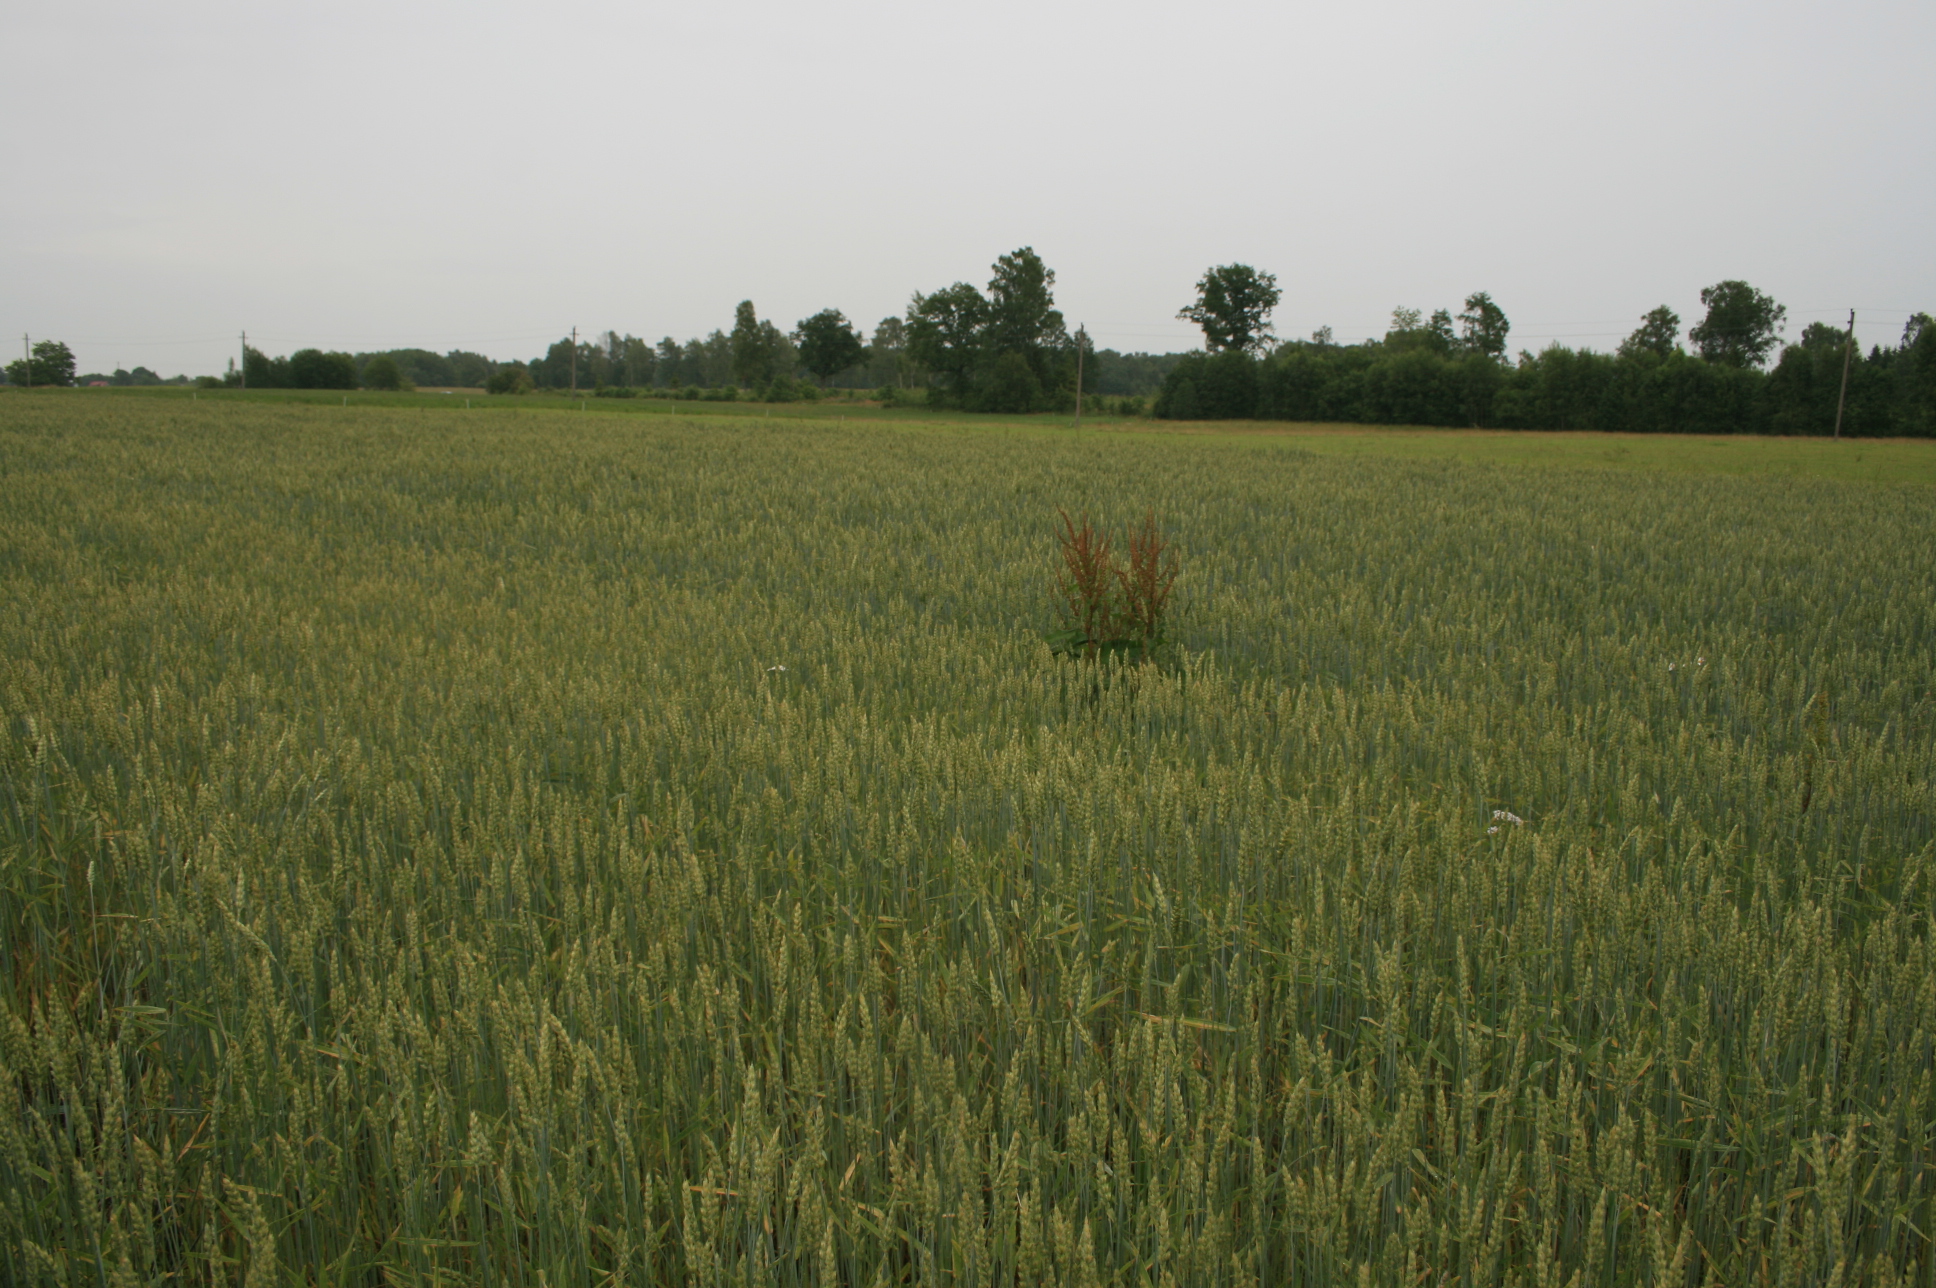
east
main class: Cropland
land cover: Common wheat
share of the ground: > 75 %
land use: Agriculture (excluding fallow land and kitchen gardens)
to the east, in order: Common wheat; Fences; Grassland without tree/shrub cover; Fences; Grass margins; Clovers; Electric lines; Clovers
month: July
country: LT
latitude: 55.5238
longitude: 22.0769
